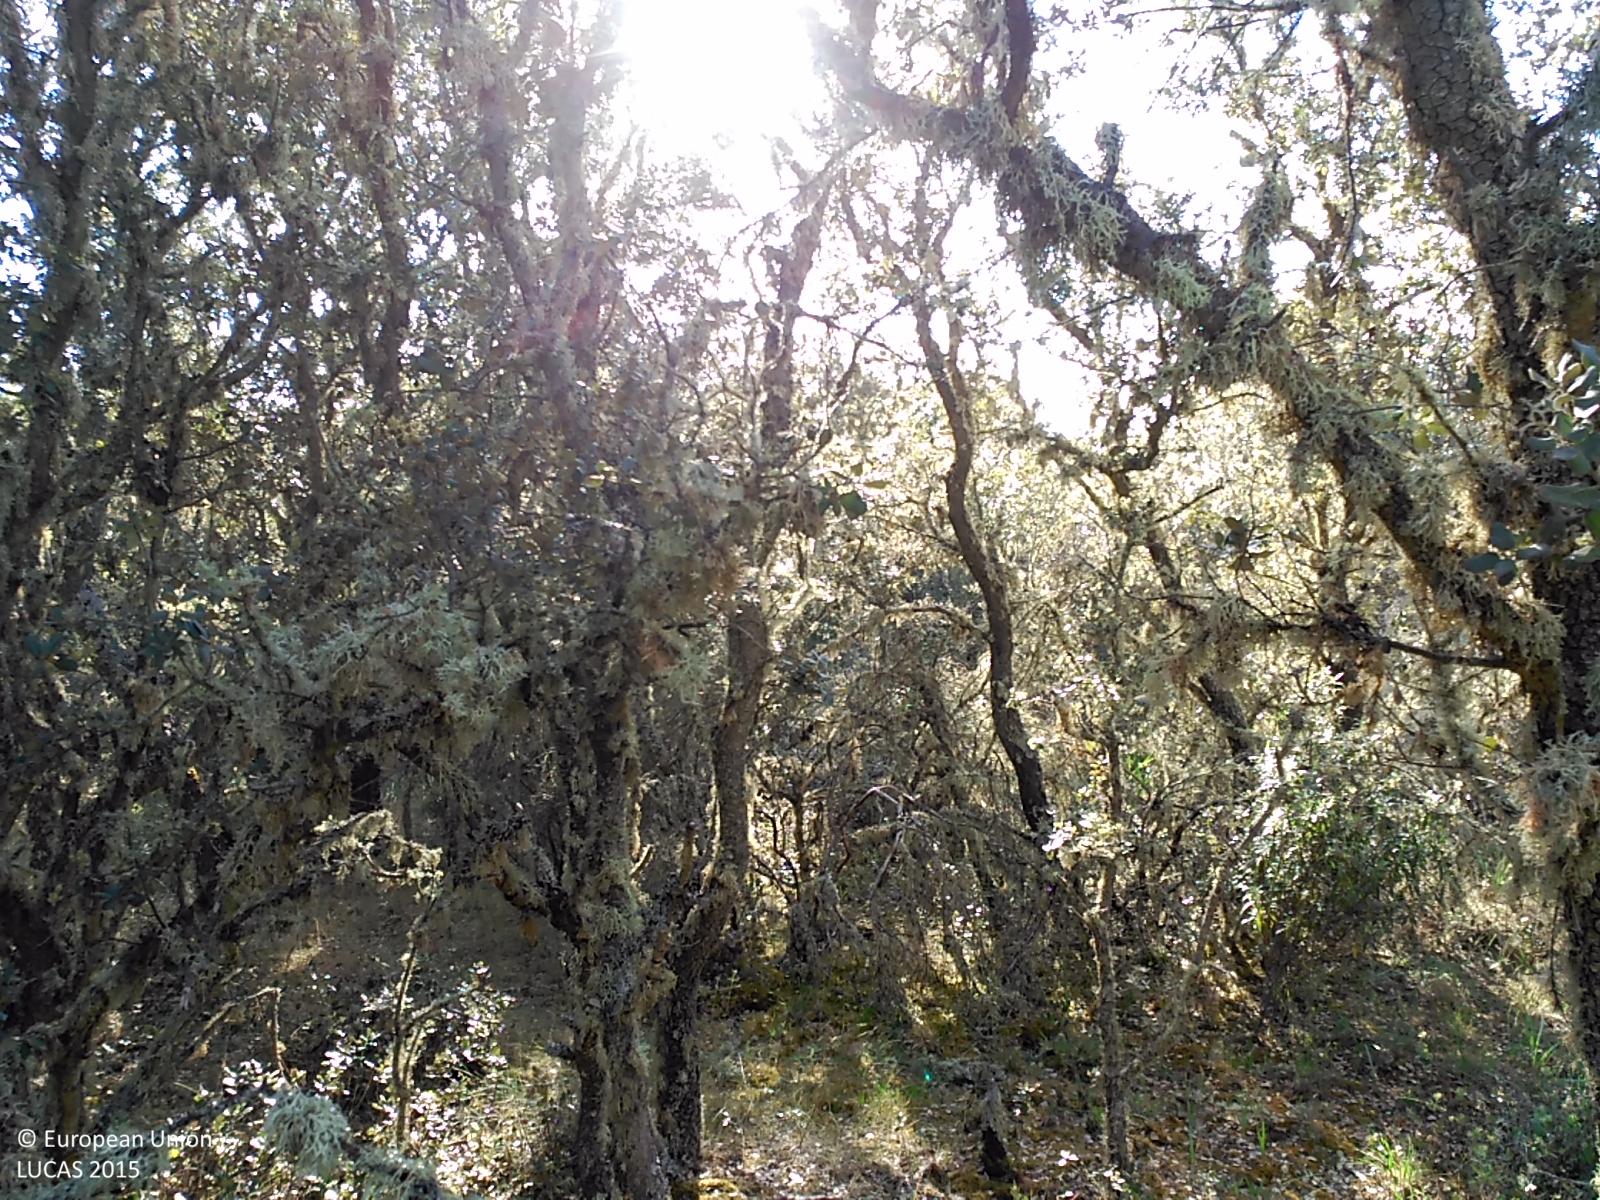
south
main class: Woodland
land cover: Broadleaved woodland
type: broadleaved evergreen forest
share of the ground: > 75 %
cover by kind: broadleaved forest trees 90 %, shrubs 10 %
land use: Forestry
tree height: > 5 m
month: May
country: ES
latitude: 42.0228
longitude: -5.9552
